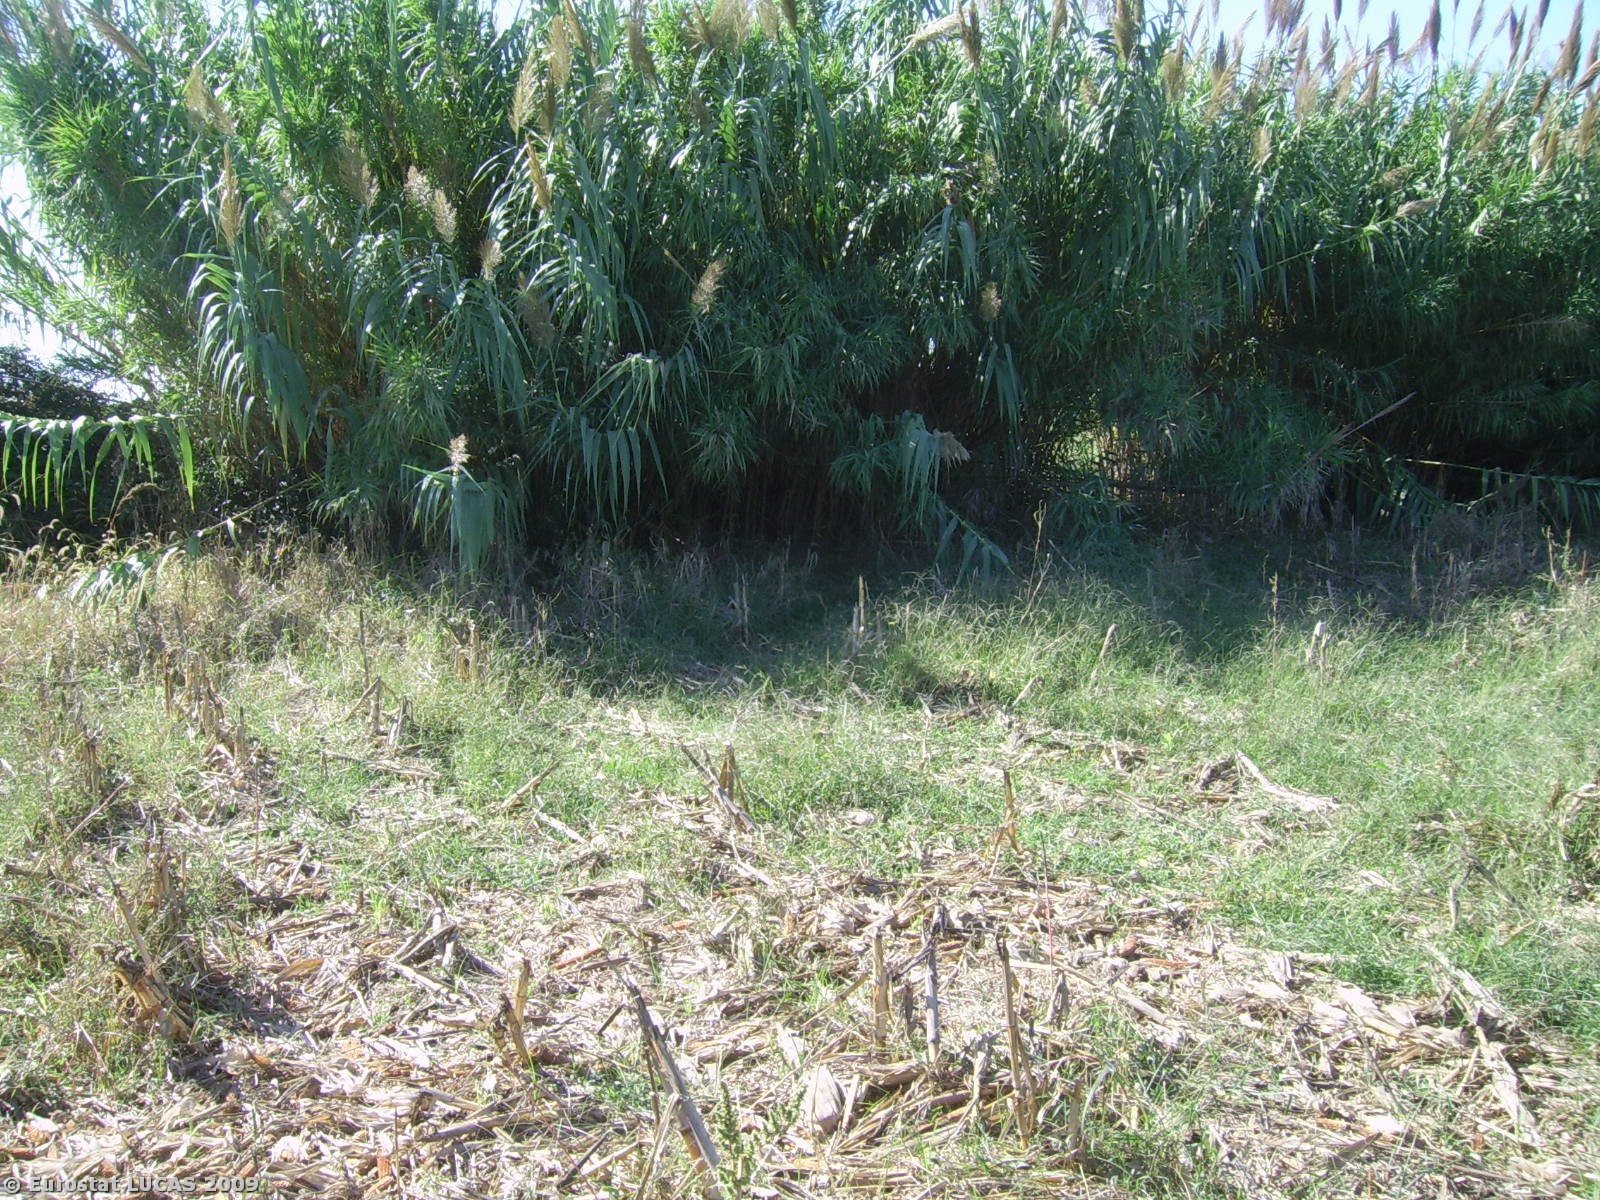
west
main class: Cropland
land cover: Maize
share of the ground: < 10 %
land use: Agriculture (excluding fallow land and kitchen gardens)
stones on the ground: < 10 %
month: October
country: GR
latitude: 37.8207
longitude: 21.3088
